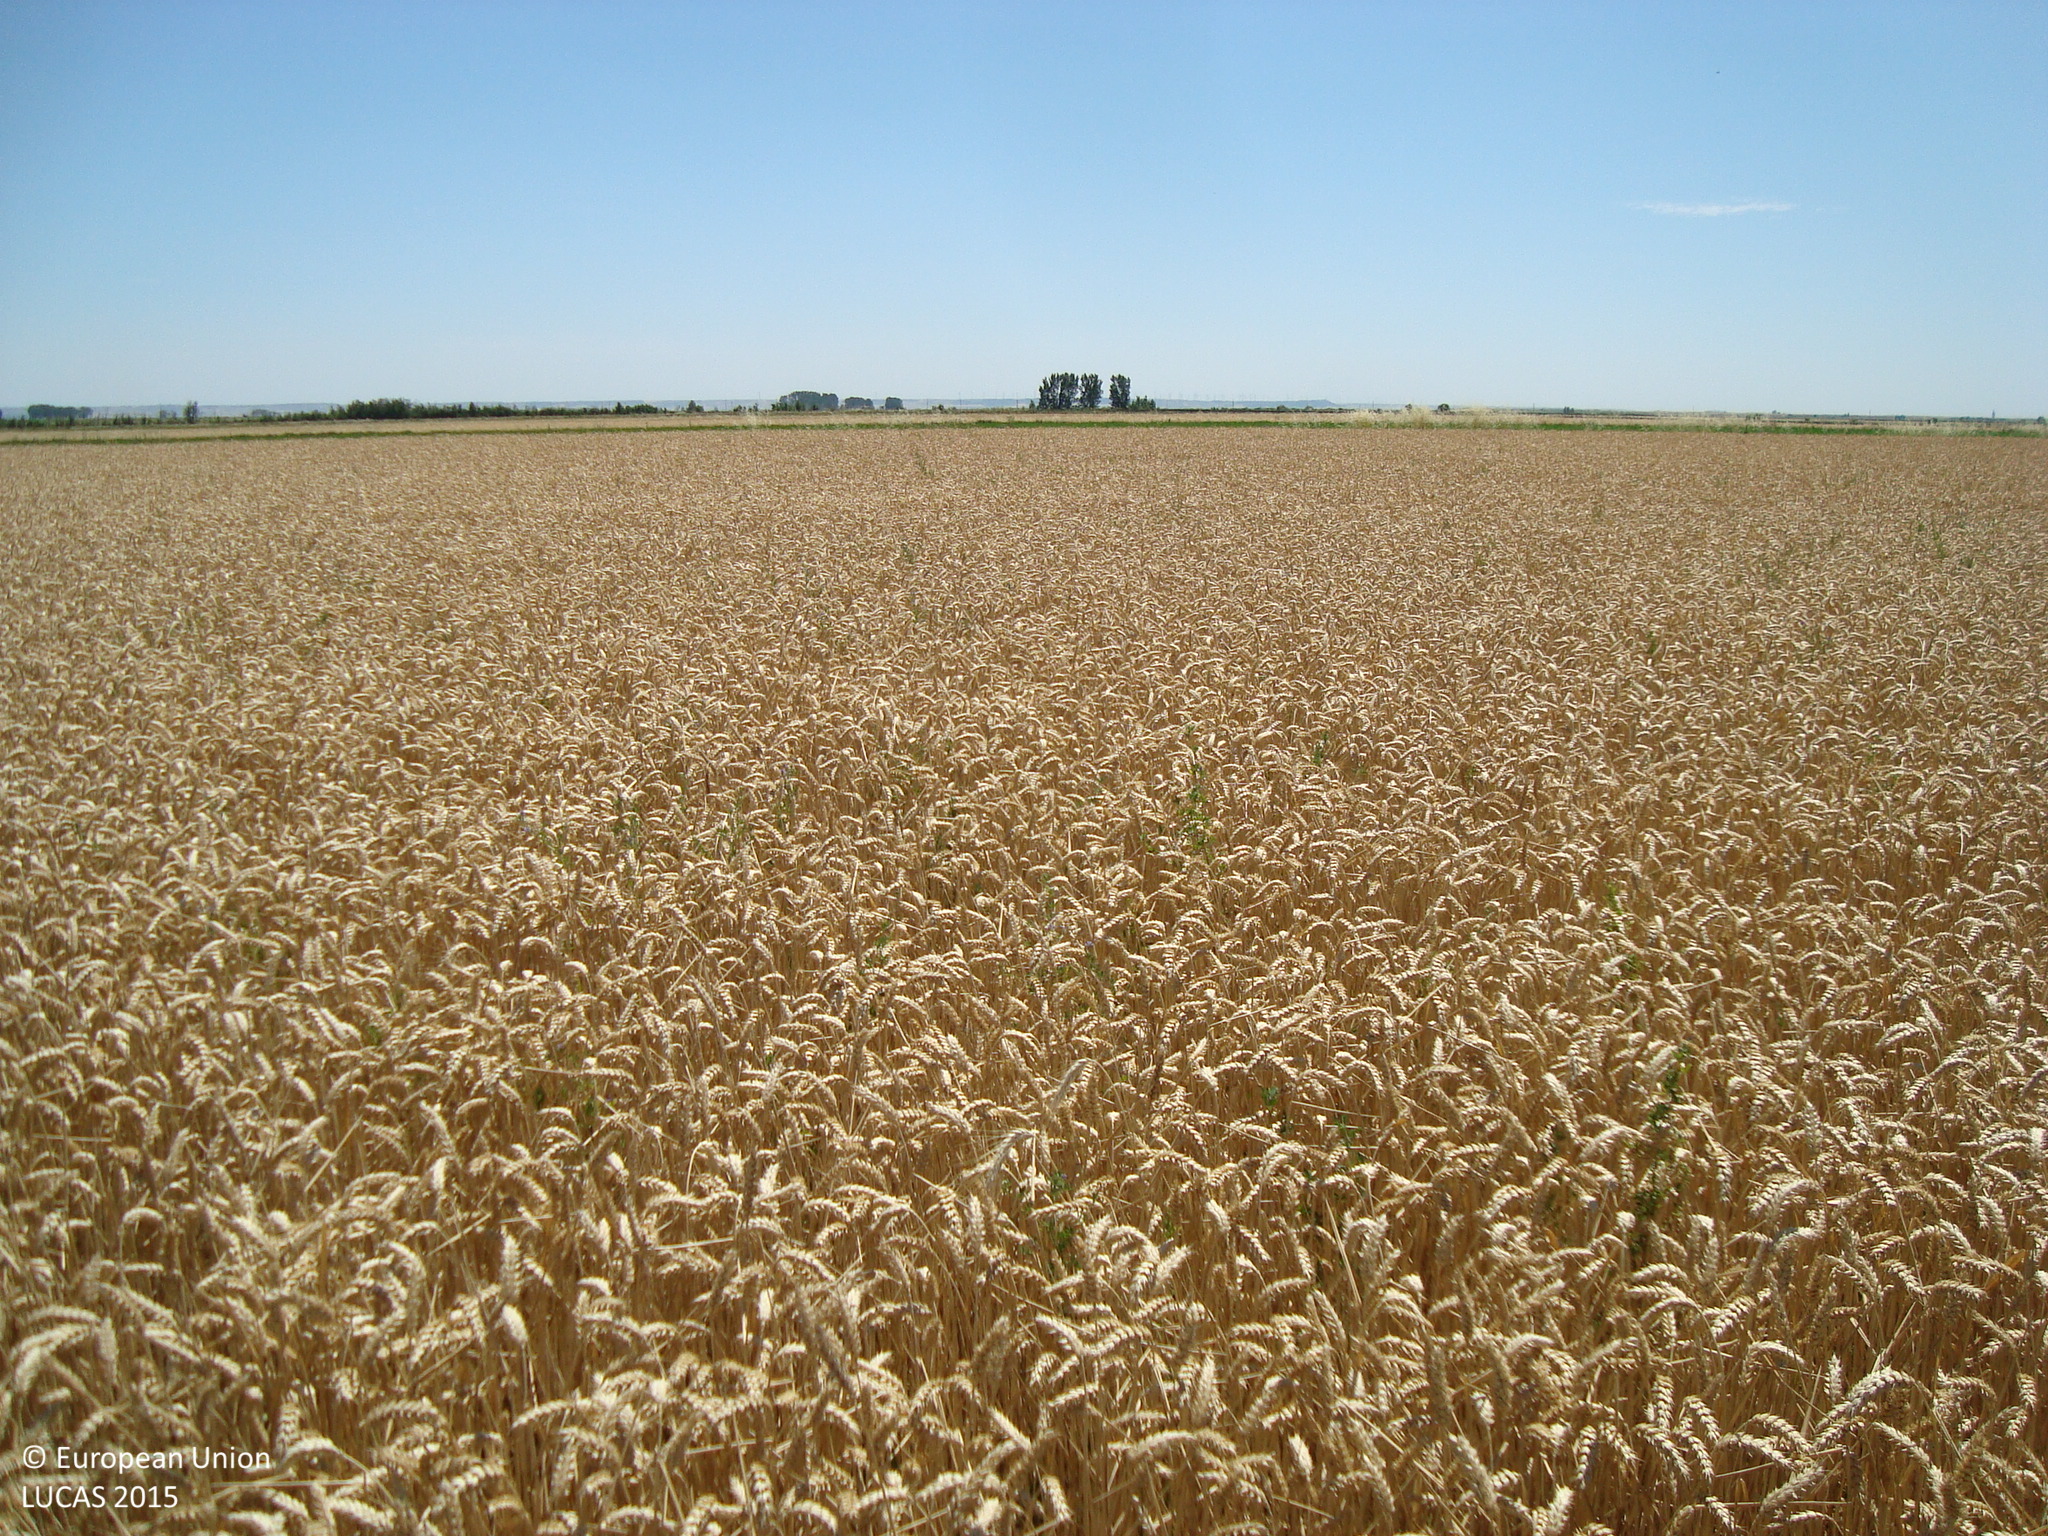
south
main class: Cropland
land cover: Common wheat
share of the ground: > 75 %
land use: Agriculture (excluding fallow land and kitchen gardens)
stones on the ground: < 10 %
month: July
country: ES
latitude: 42.1566
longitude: -4.7316
